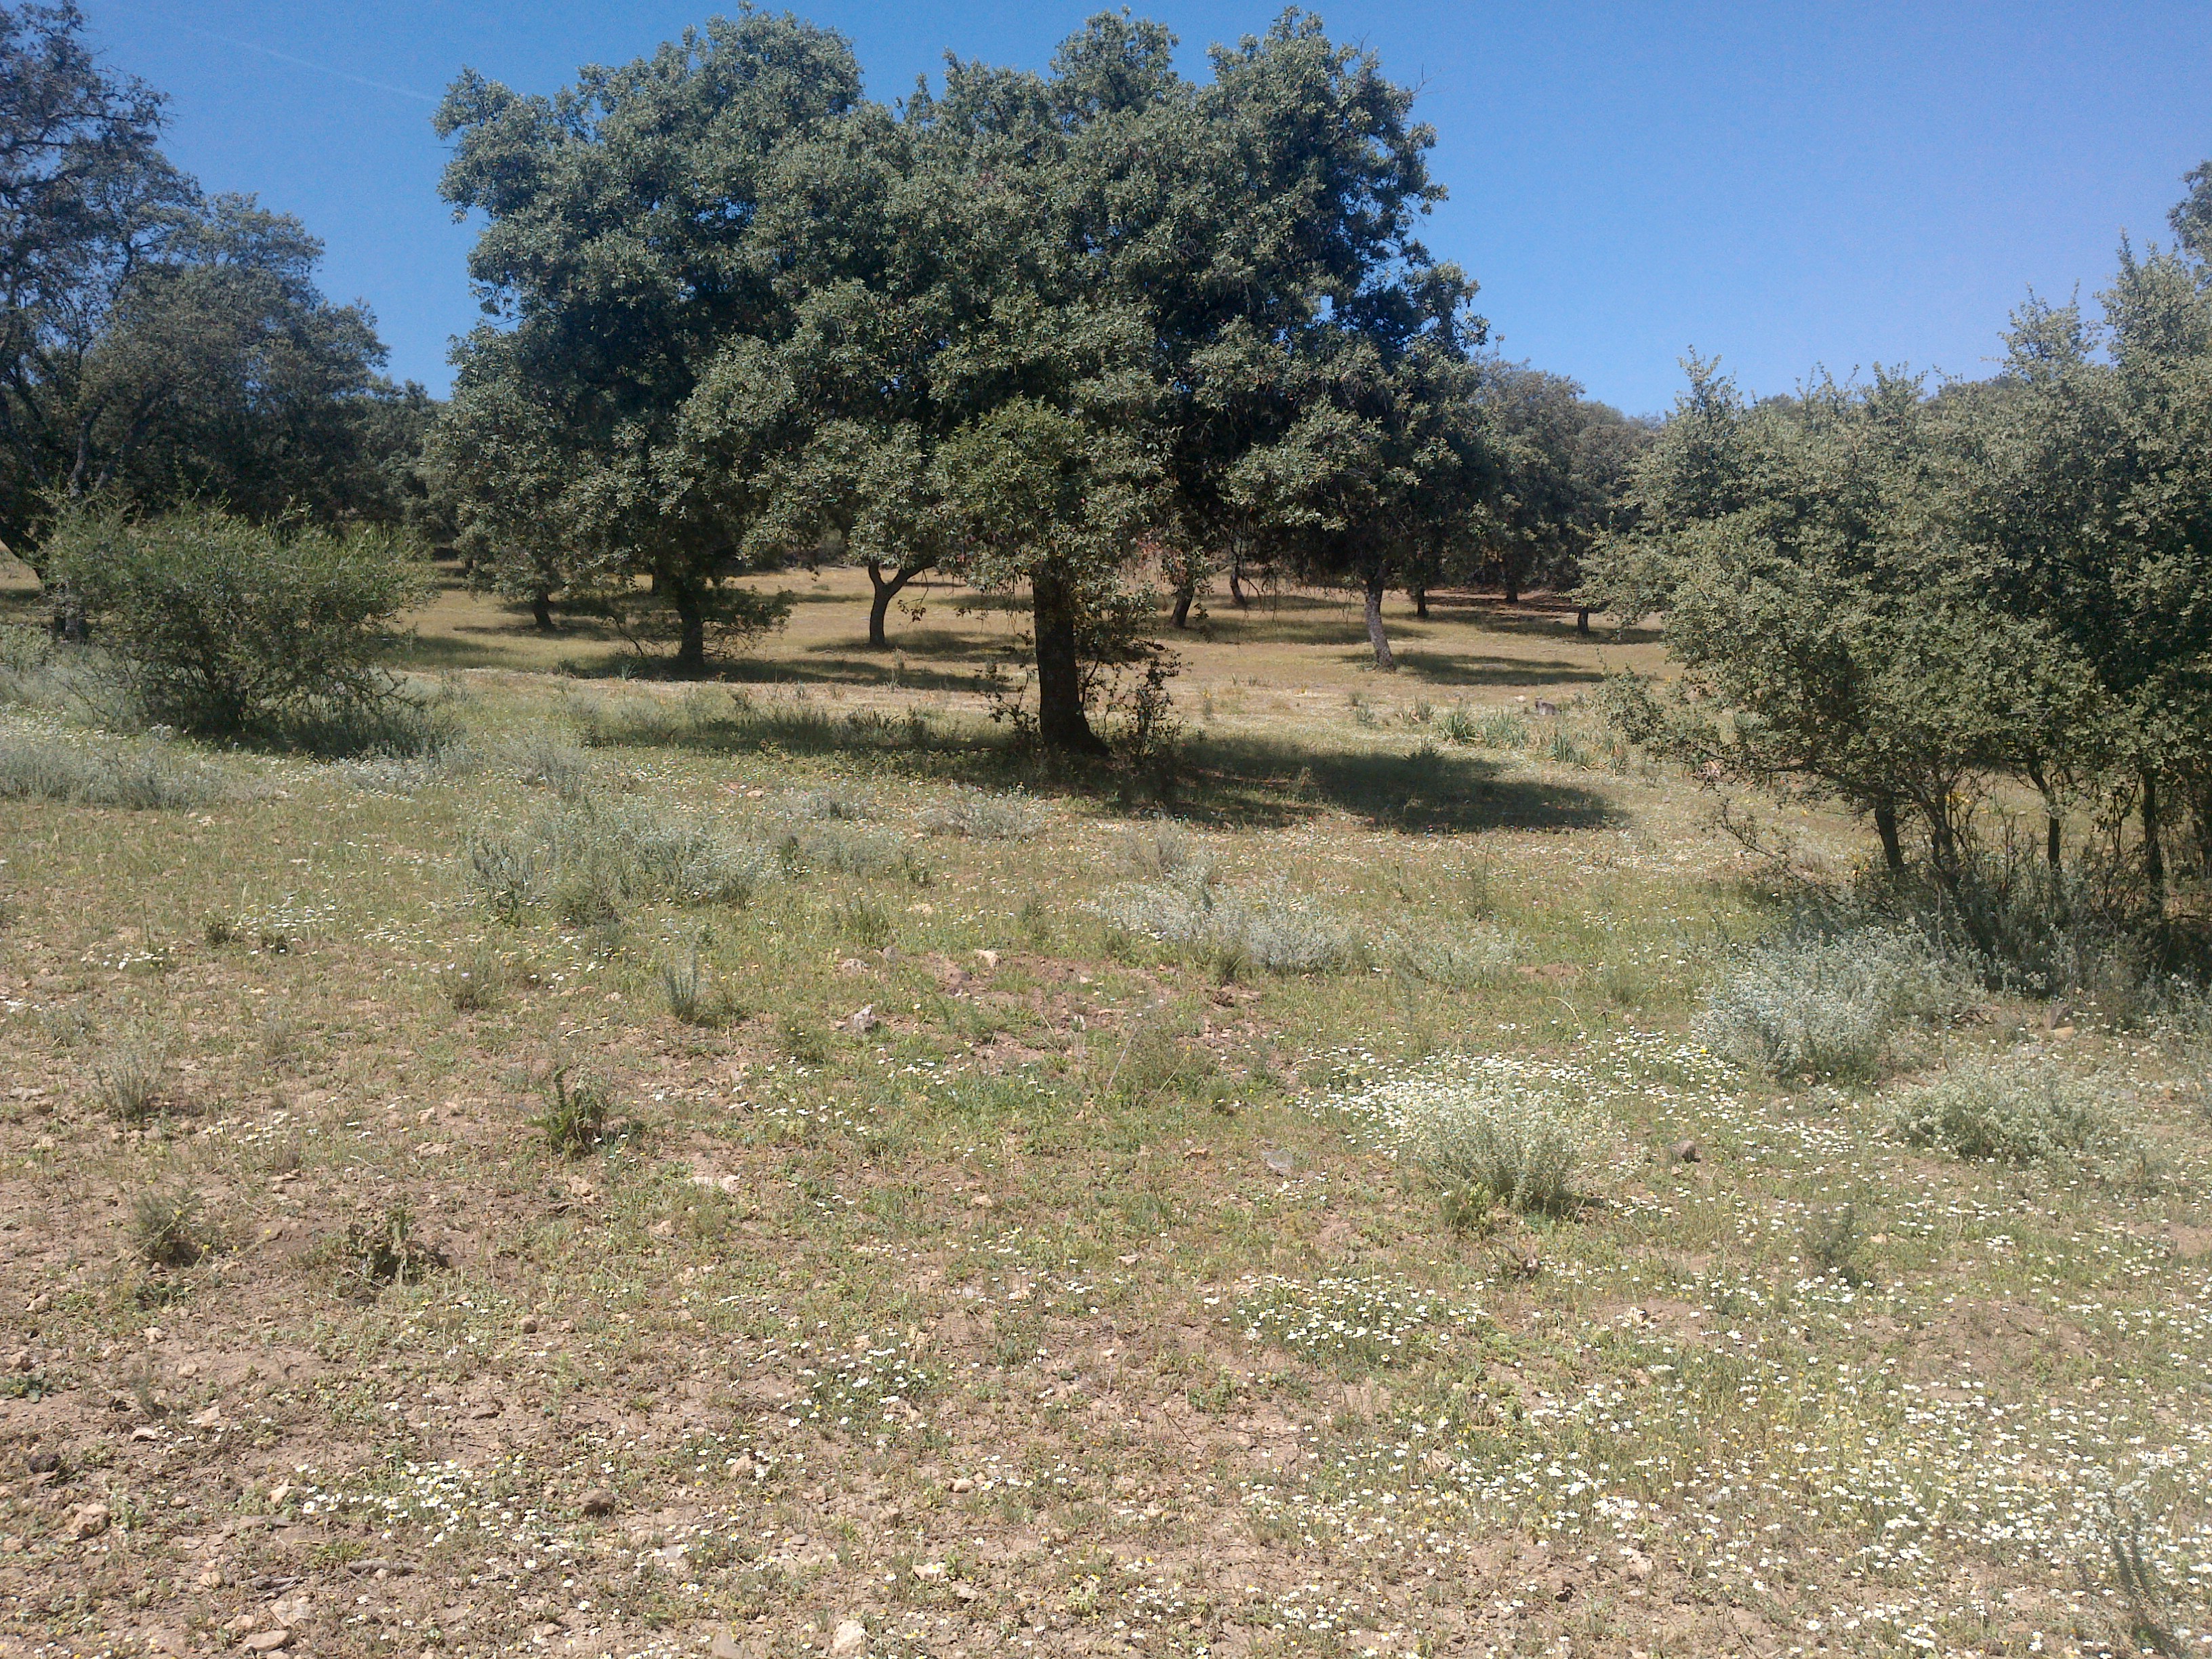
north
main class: Woodland
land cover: Broadleaved woodland
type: broadleaved evergreen forest
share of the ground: 10 - 25 %
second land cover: Spontaneously vegetated surfaces
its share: > 75 %
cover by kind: herbaceous plants 85 %, broadleaved forest trees 15 %
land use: Forestry
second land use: Agriculture (excluding fallow land and kitchen gardens)
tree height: > 5 m
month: May
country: ES
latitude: 37.8982
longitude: -4.9718
